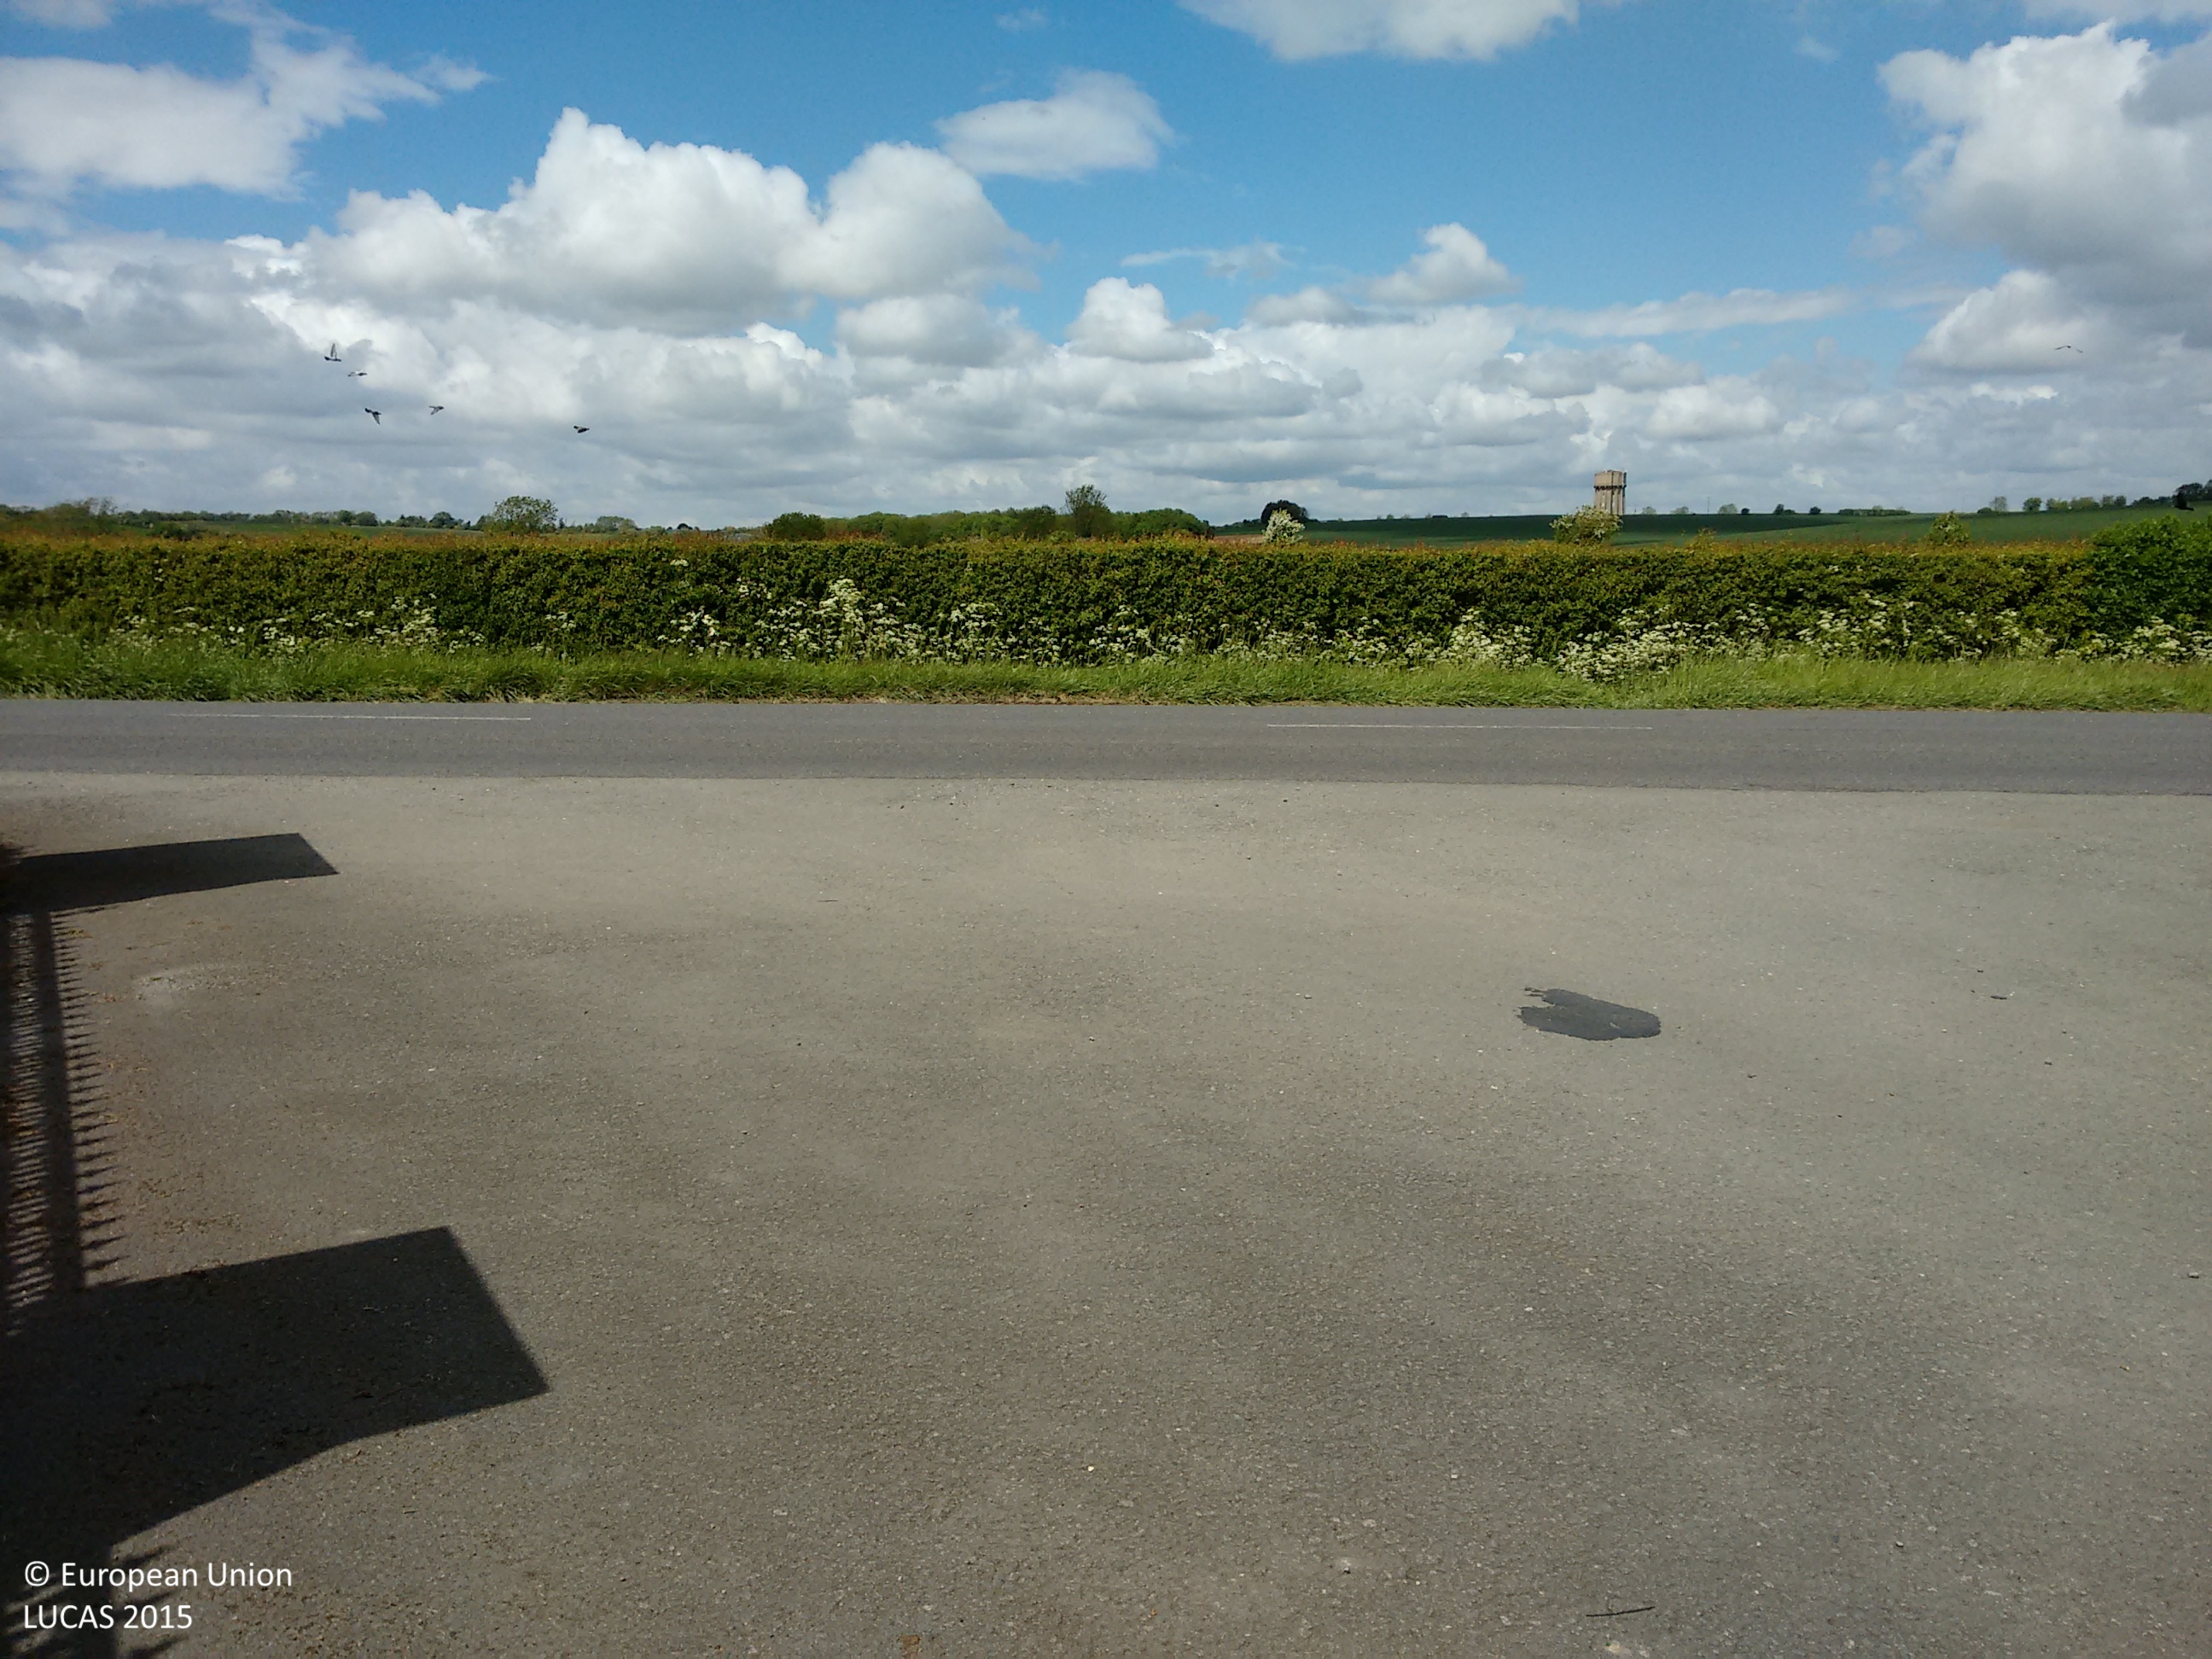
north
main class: Cropland
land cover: Dry pulses
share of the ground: 25 - 50 %
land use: Agriculture (excluding fallow land and kitchen gardens)
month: May
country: GB
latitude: 51.9978
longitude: -0.3339
